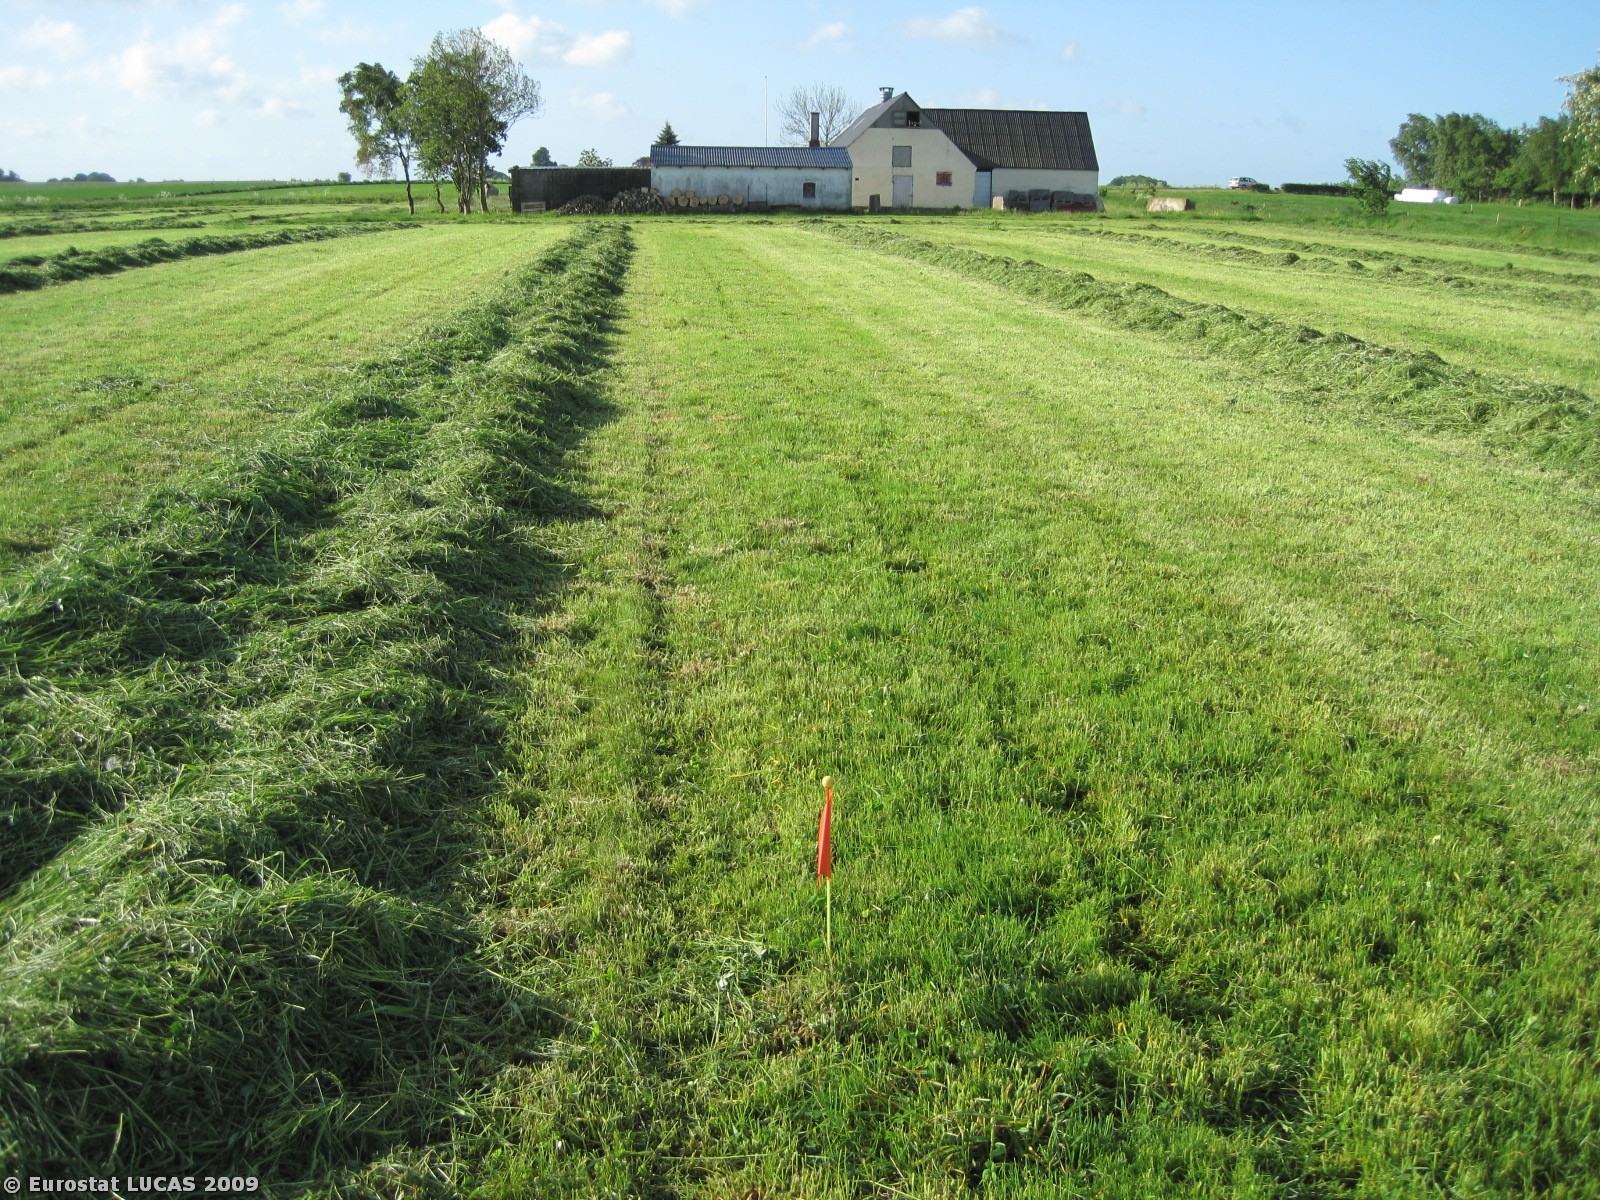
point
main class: Grassland
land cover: Grassland without tree/shrub cover
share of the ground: > 75 %
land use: Agriculture (excluding fallow land and kitchen gardens)
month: May
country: DK
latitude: 56.5111
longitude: 9.7566
